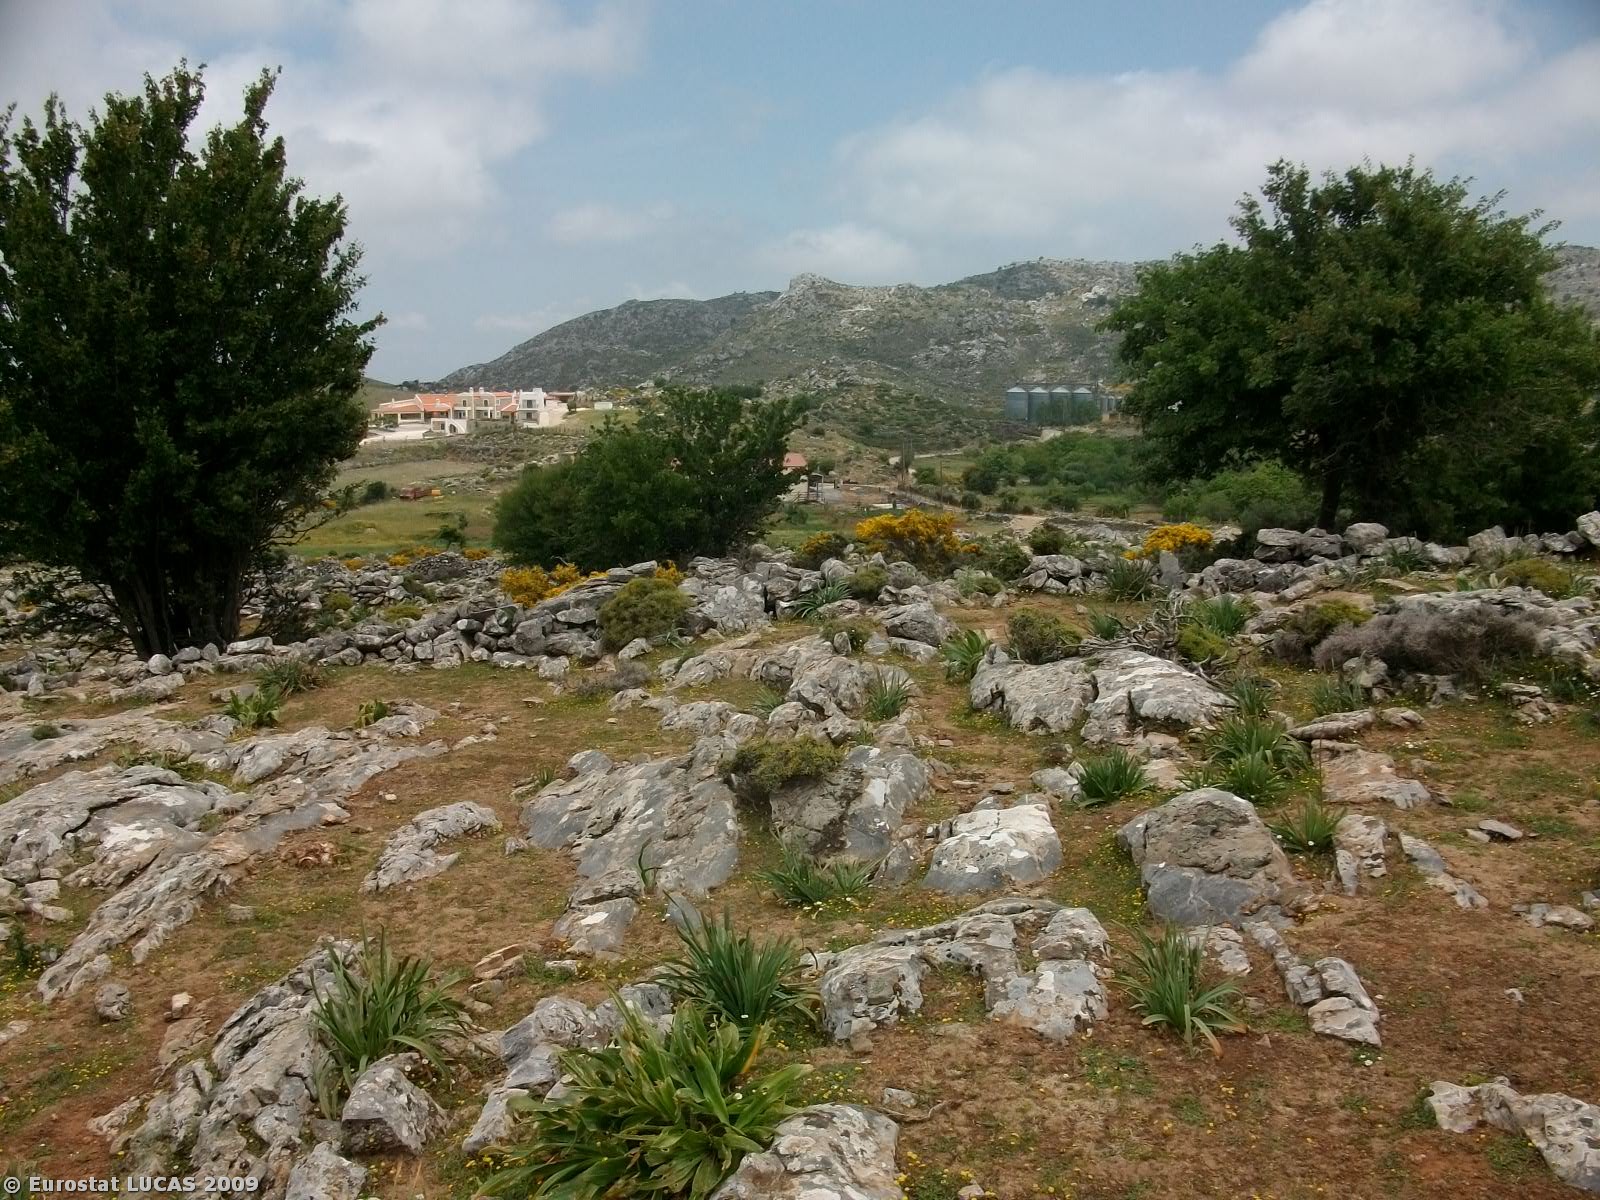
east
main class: Shrubland
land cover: Shrubland with sparse tree cover
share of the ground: > 75 %
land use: Agriculture (excluding fallow land and kitchen gardens)
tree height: < 5 m
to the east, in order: Shrubland with sparse tree cover; Dry stone walls; Shrubland with sparse tree cover; Dry stone walls; Shrubland without tree cover; Fences; Grassland with sparse tree/shrub cover; Fences; Grassland without tree/shrub cover; Fences; Artificial constructions in urban areas; Fences; Grassland without tree/shrub cover
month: May
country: GR
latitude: 35.2792
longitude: 24.8867
